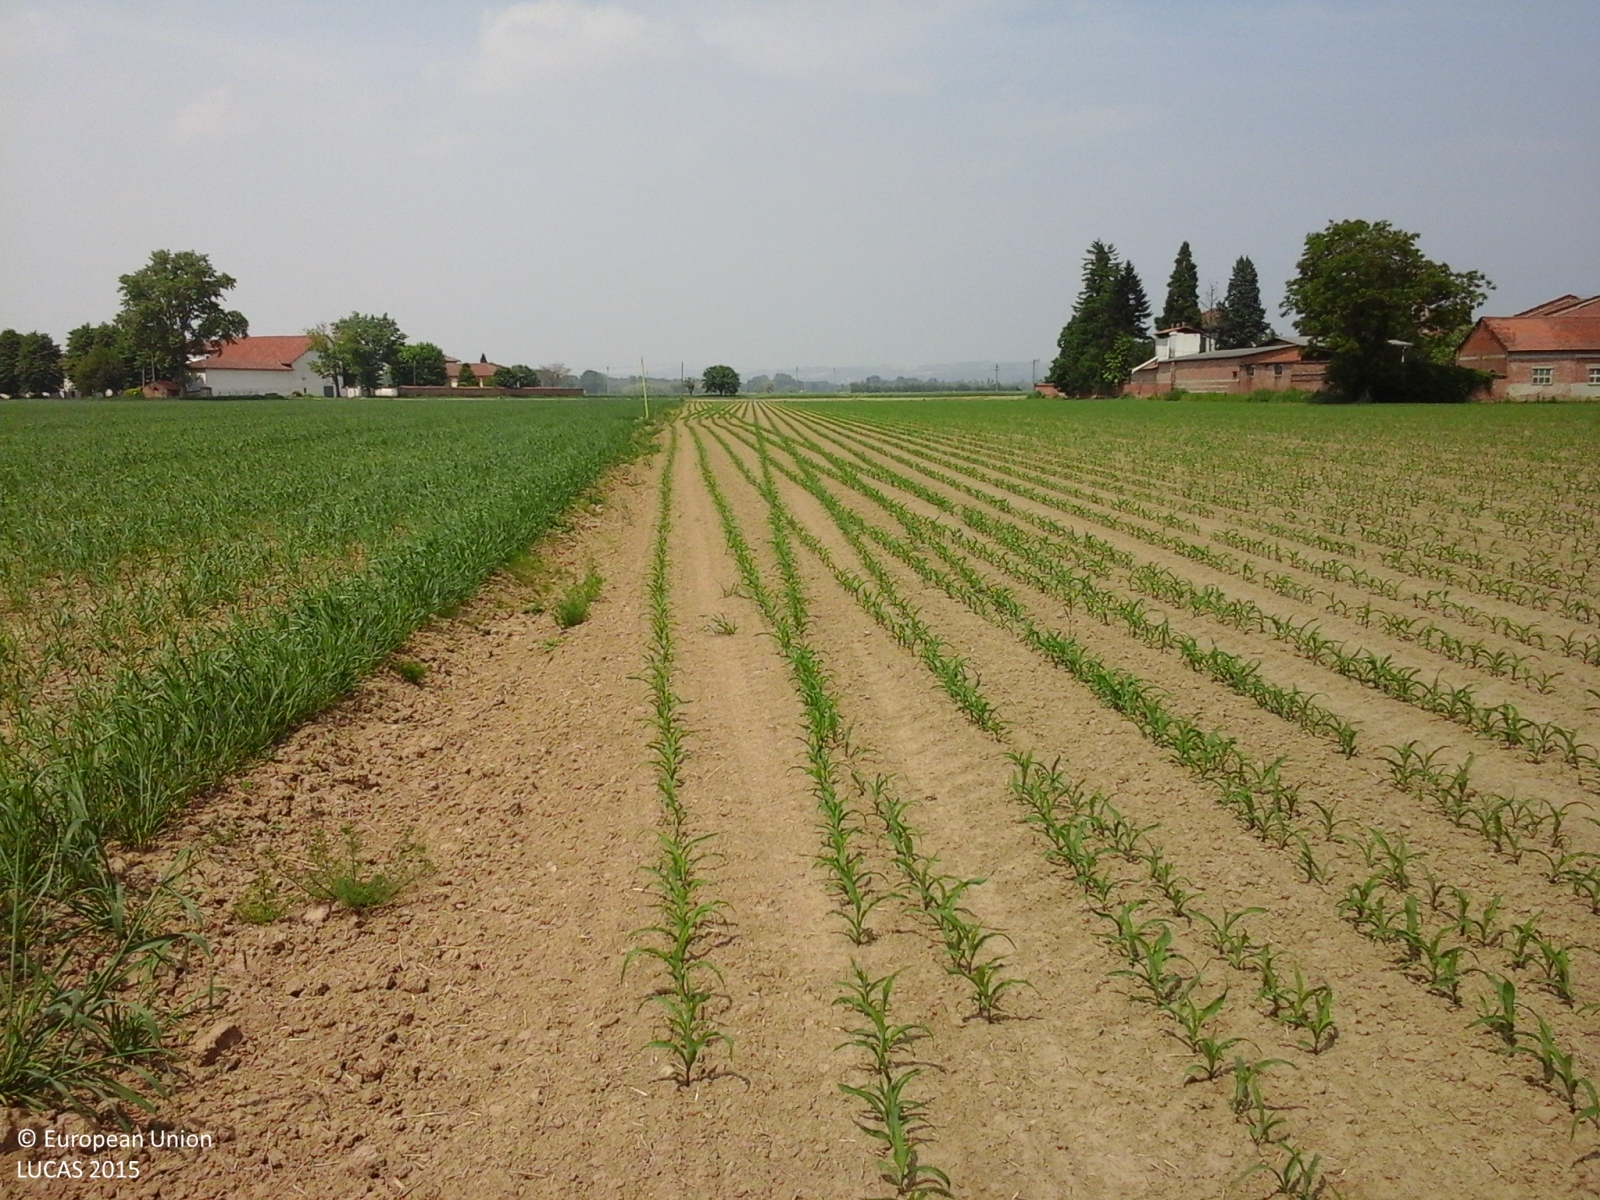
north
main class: Cropland
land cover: Maize
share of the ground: < 10 %
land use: Agriculture (excluding fallow land and kitchen gardens)
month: May
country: IT
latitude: 44.8828
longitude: 8.6480
